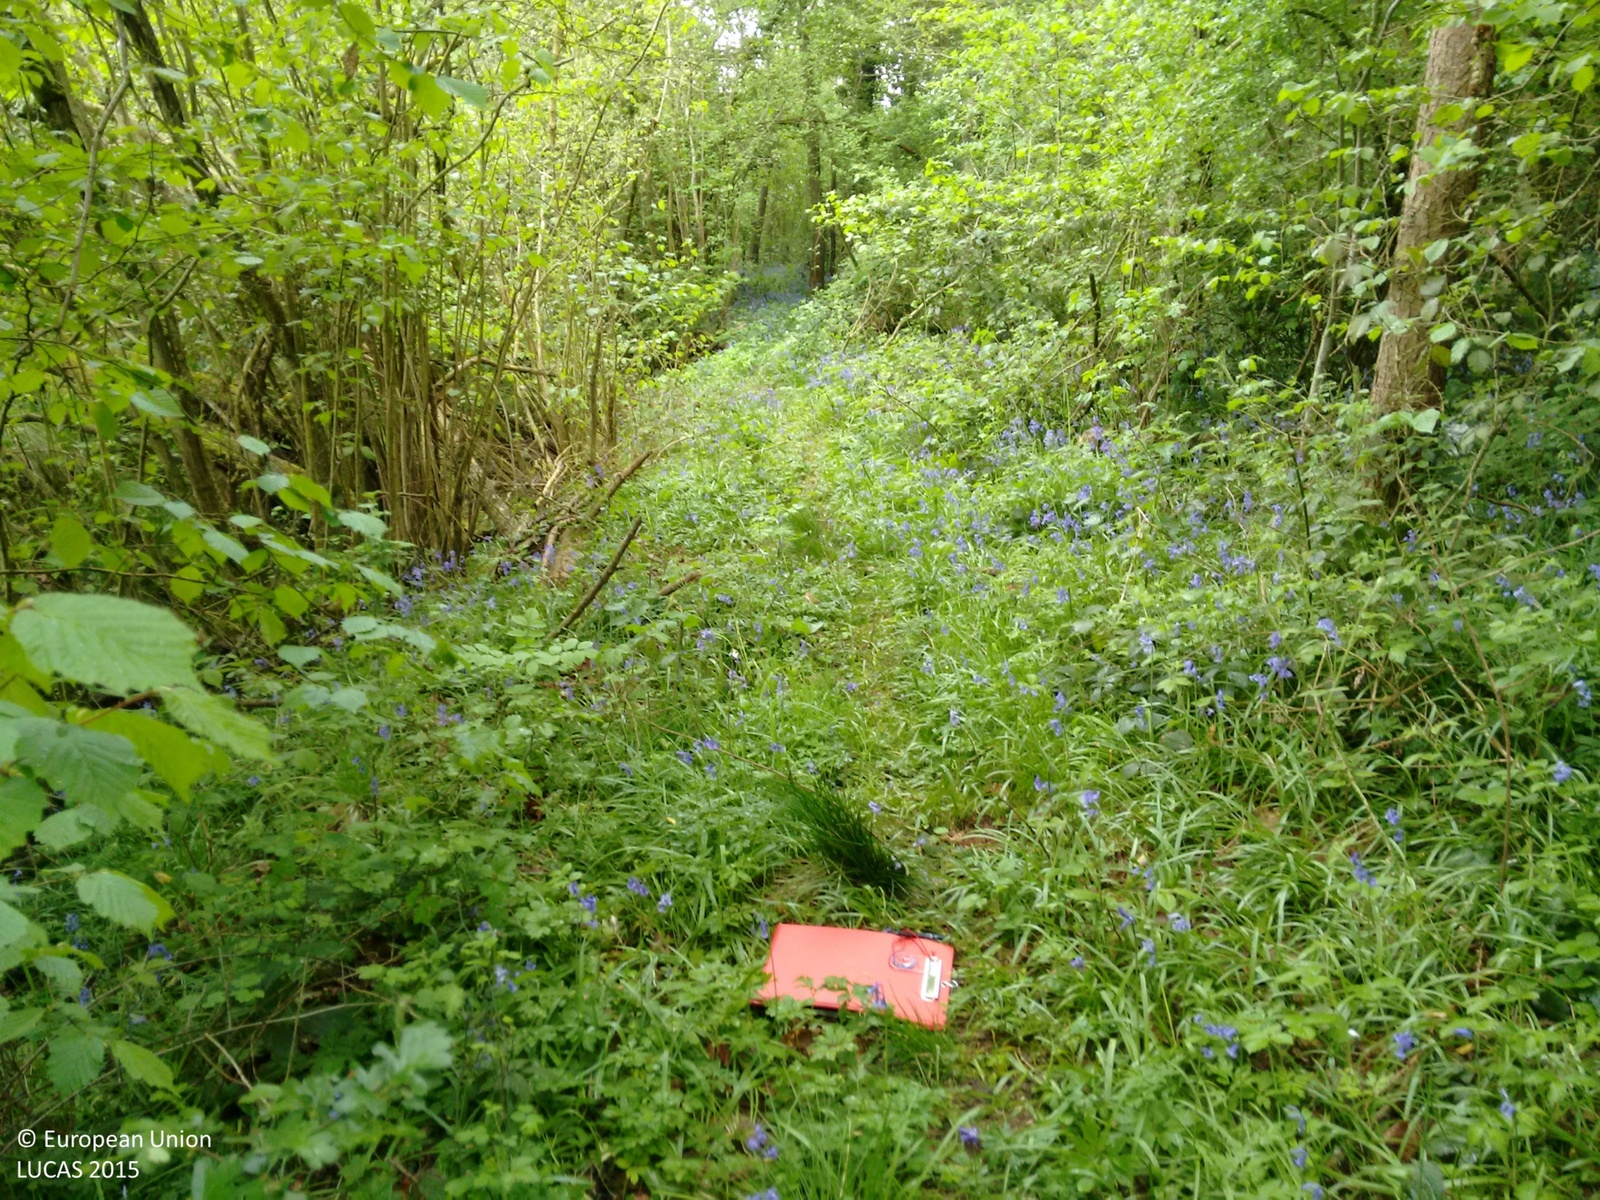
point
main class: Woodland
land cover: Broadleaved woodland
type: mesophytic deciduous forest
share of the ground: > 75 %
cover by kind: broadleaved forest trees 85 %, herbaceous plants 10 %, shrubs 5 %
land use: Semi-natural and natural areas not in use
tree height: > 5 m
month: May
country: GB
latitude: 52.2924
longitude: -2.1865
